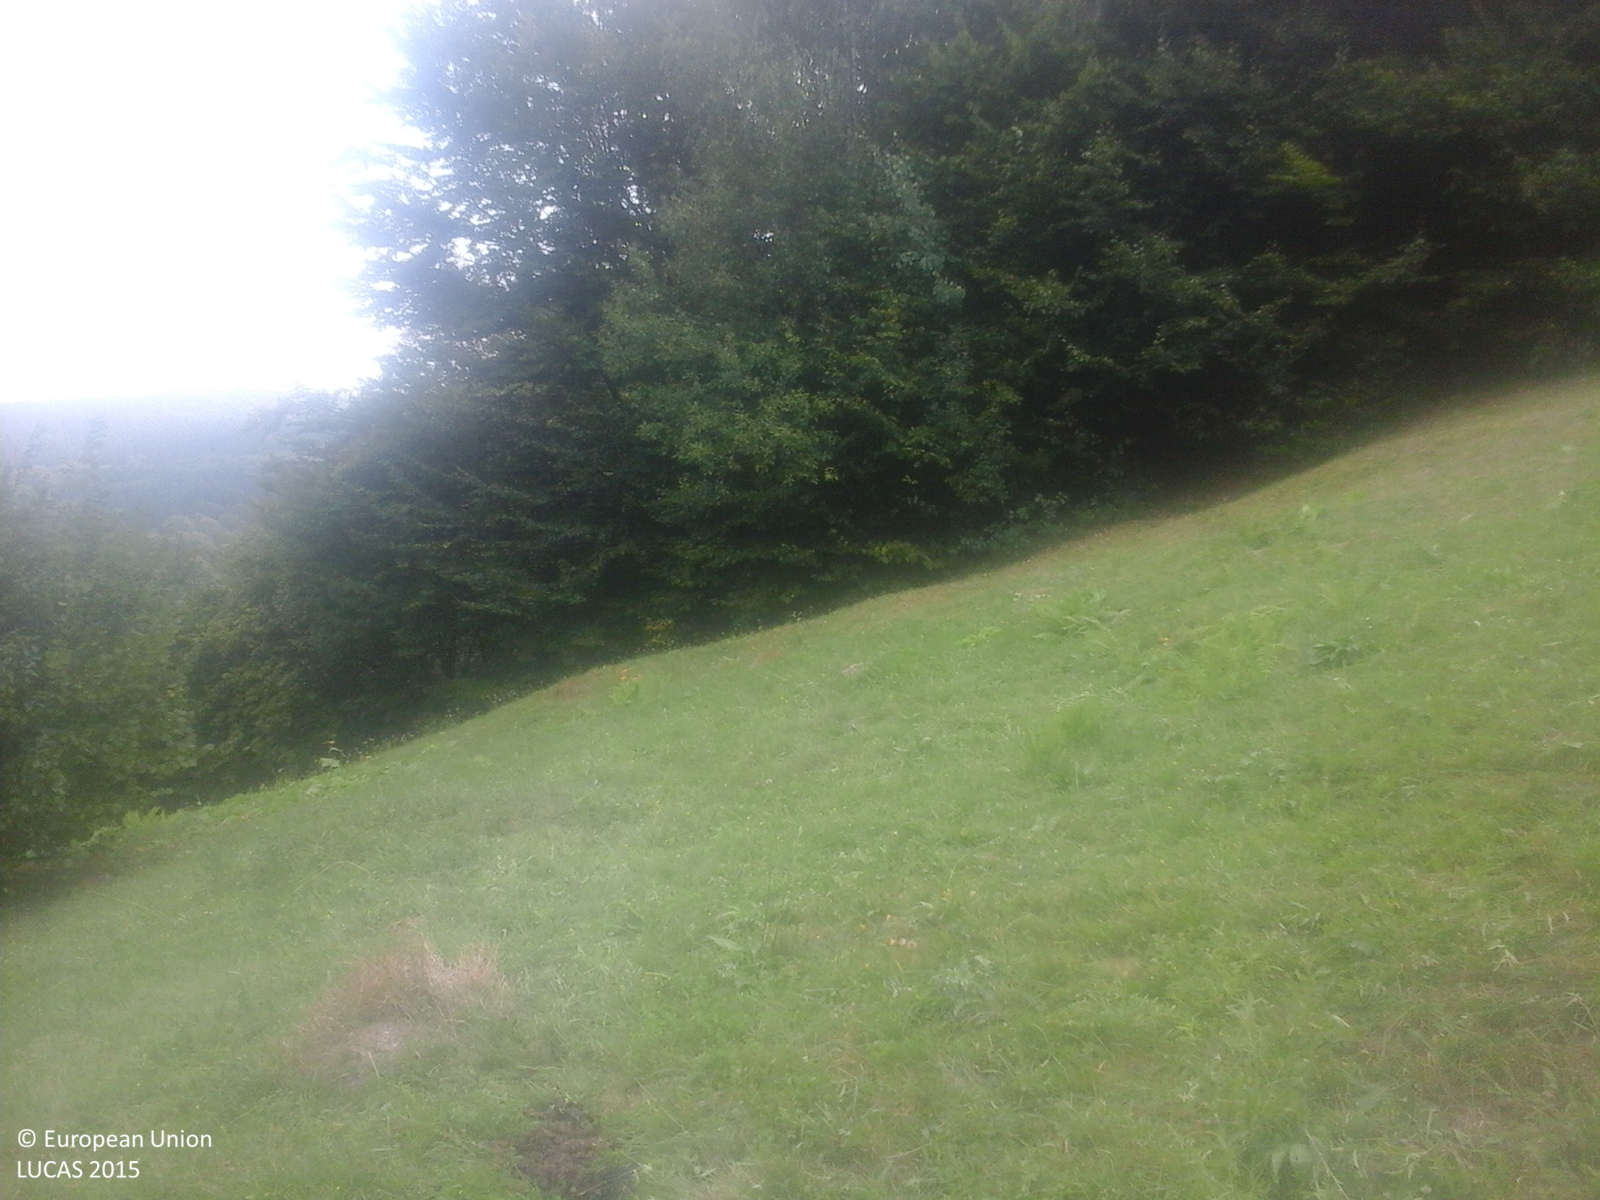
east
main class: Grassland
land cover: Grassland without tree/shrub cover
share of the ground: > 75 %
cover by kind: herbaceous plants 100 %
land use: Agriculture (excluding fallow land and kitchen gardens)
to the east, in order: Grassland without tree/shrub cover; Broadleaved woodland; Grassland without tree/shrub cover; Broadleaved woodland; Artificial constructions in urban areas; Broadleaved woodland
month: September
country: RO
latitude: 47.6267
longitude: 24.3429
